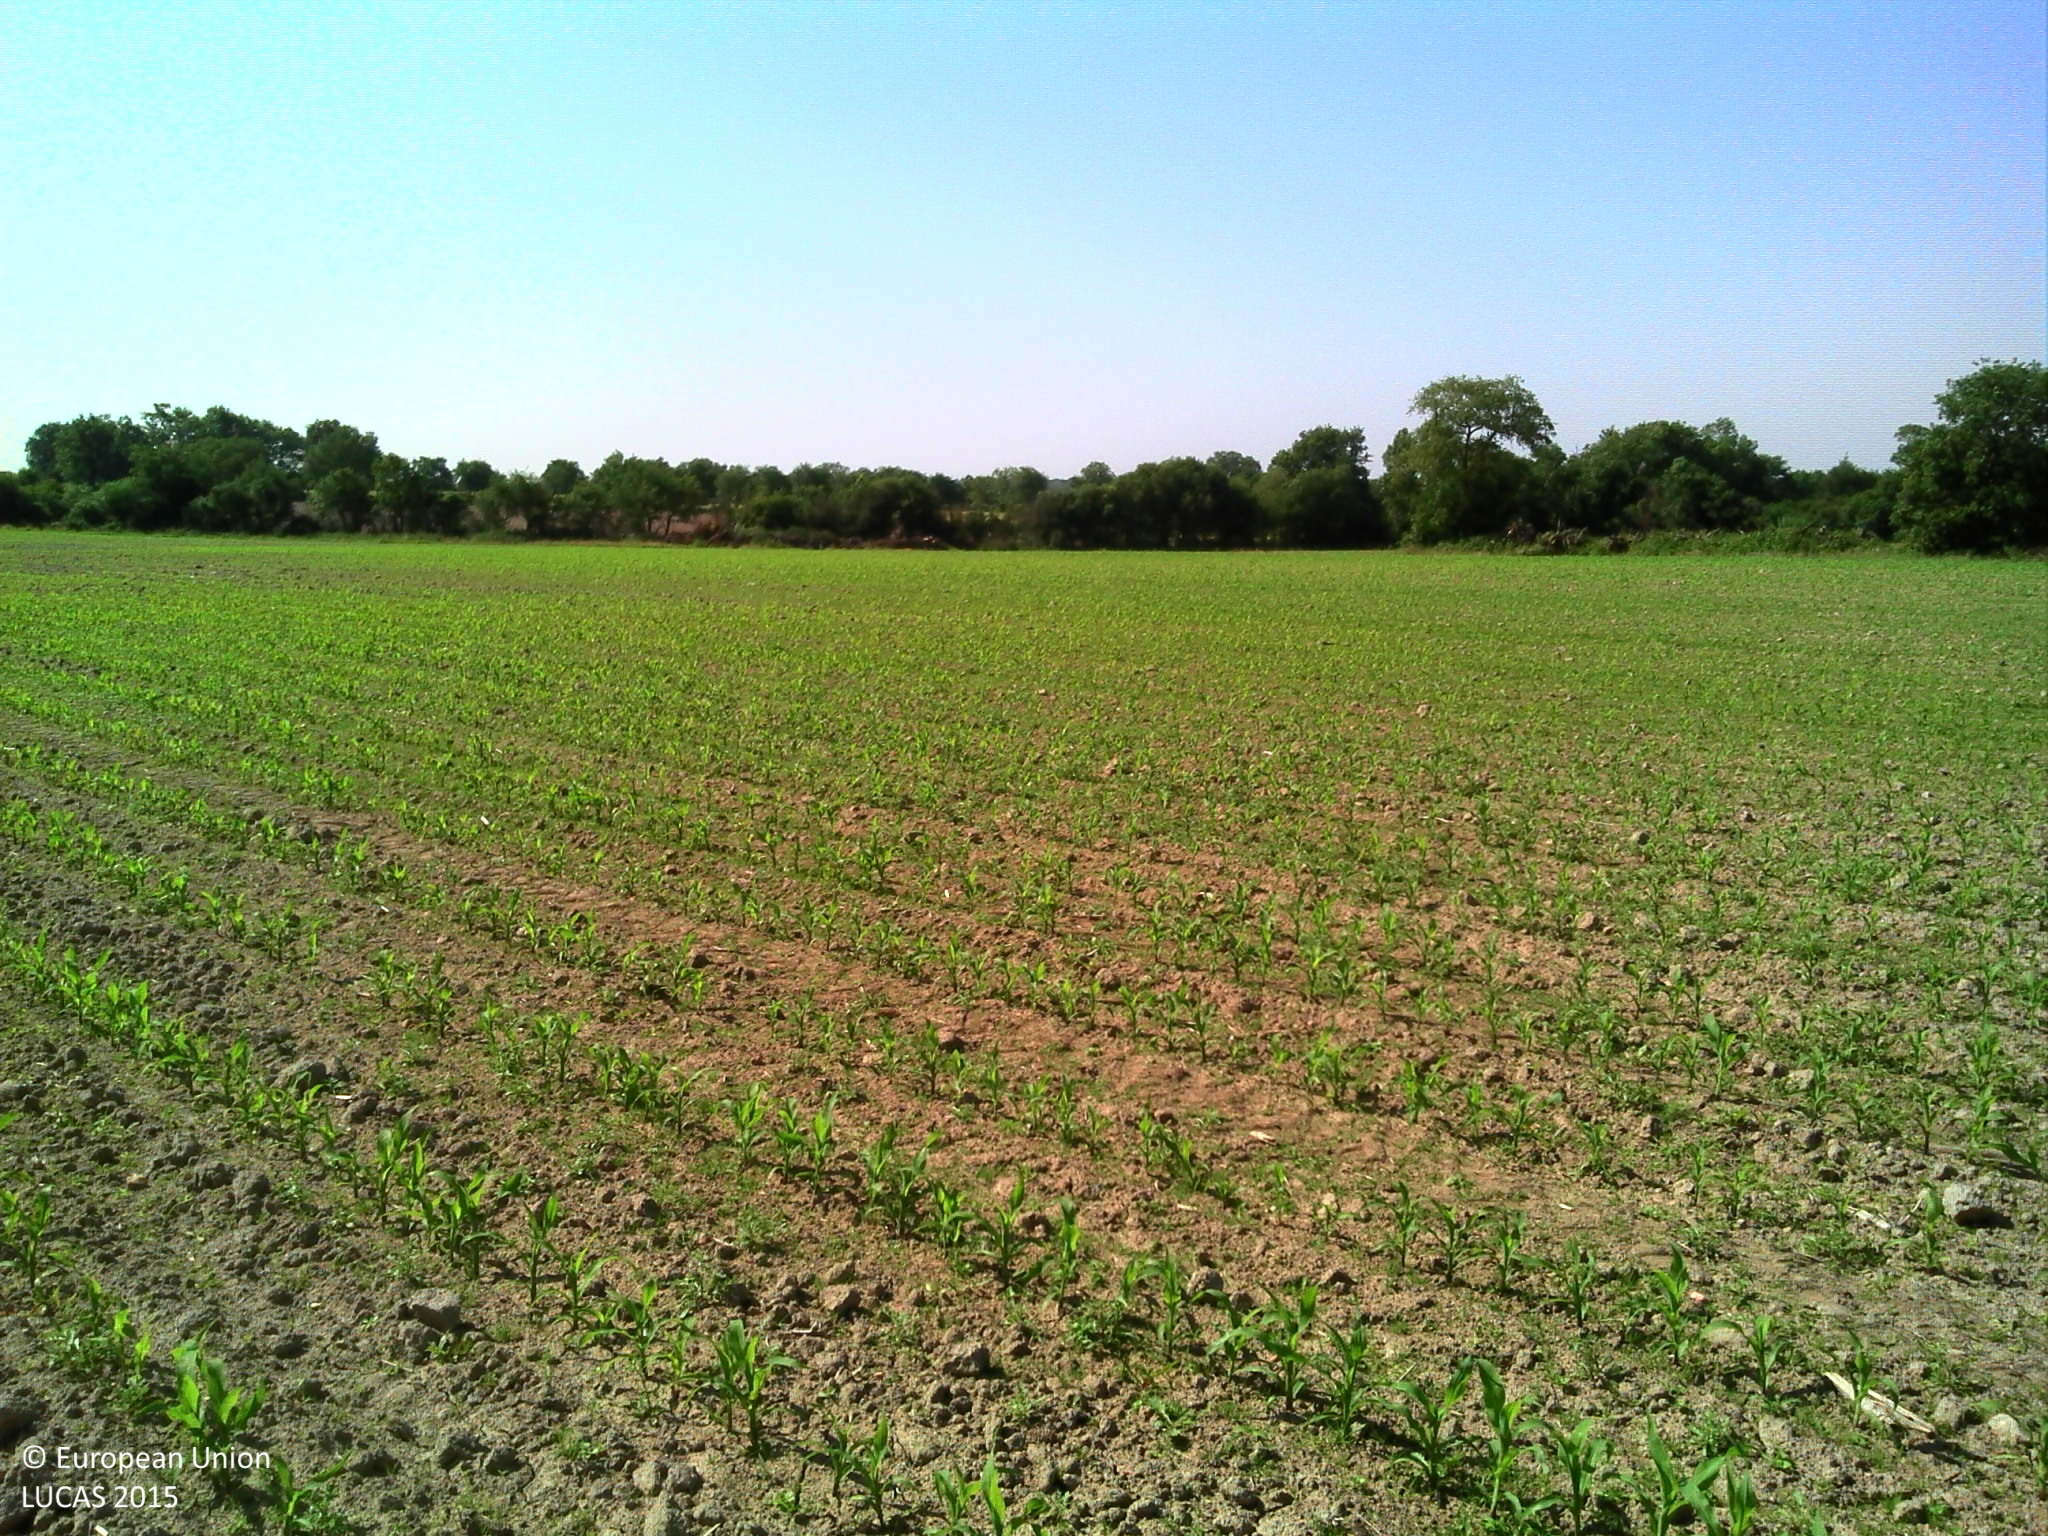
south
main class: Cropland
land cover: Maize
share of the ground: 10 - 25 %
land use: Agriculture (excluding fallow land and kitchen gardens)
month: June
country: FR
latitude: 47.0678
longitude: -1.2166
